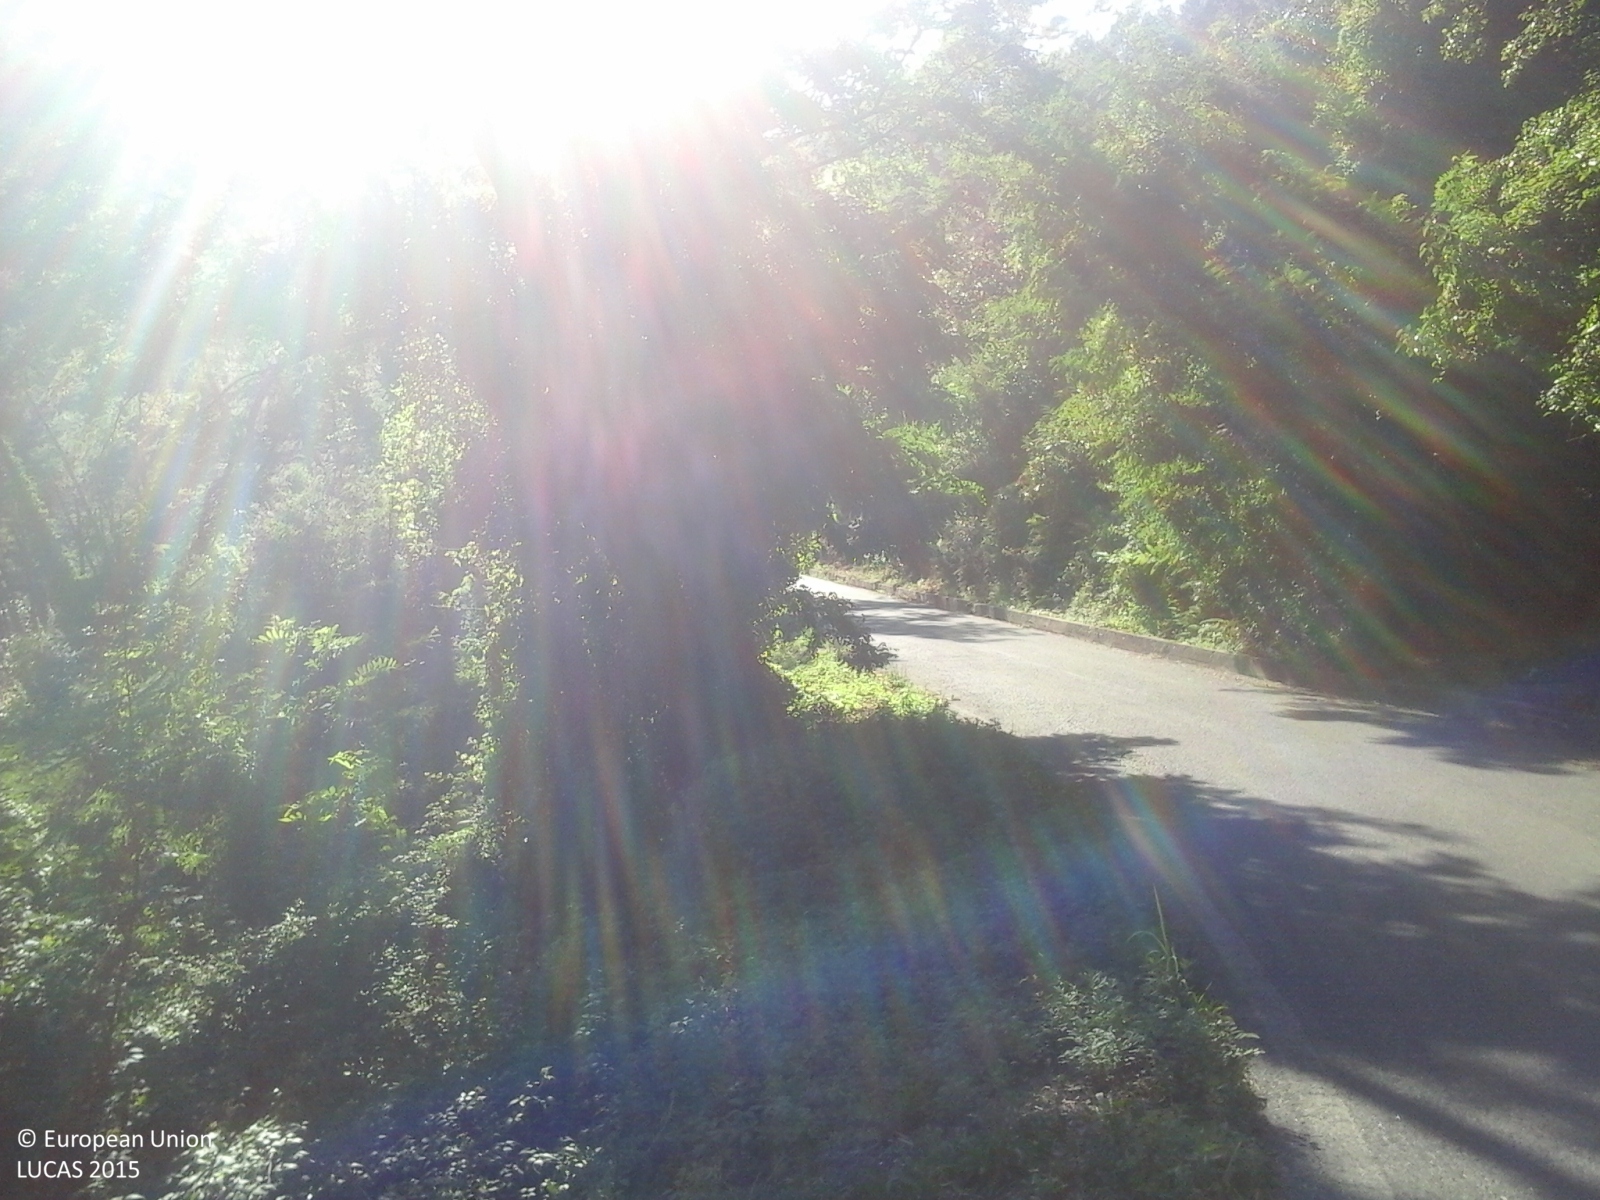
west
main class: Woodland
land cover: Pine dominated coniferous woodland
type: coniferous forest of the mediterranean region
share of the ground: > 75 %
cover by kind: coniferous forest trees 100 %
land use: Forestry
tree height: > 5 m
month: August
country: IT
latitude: 43.7357
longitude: 10.5572
